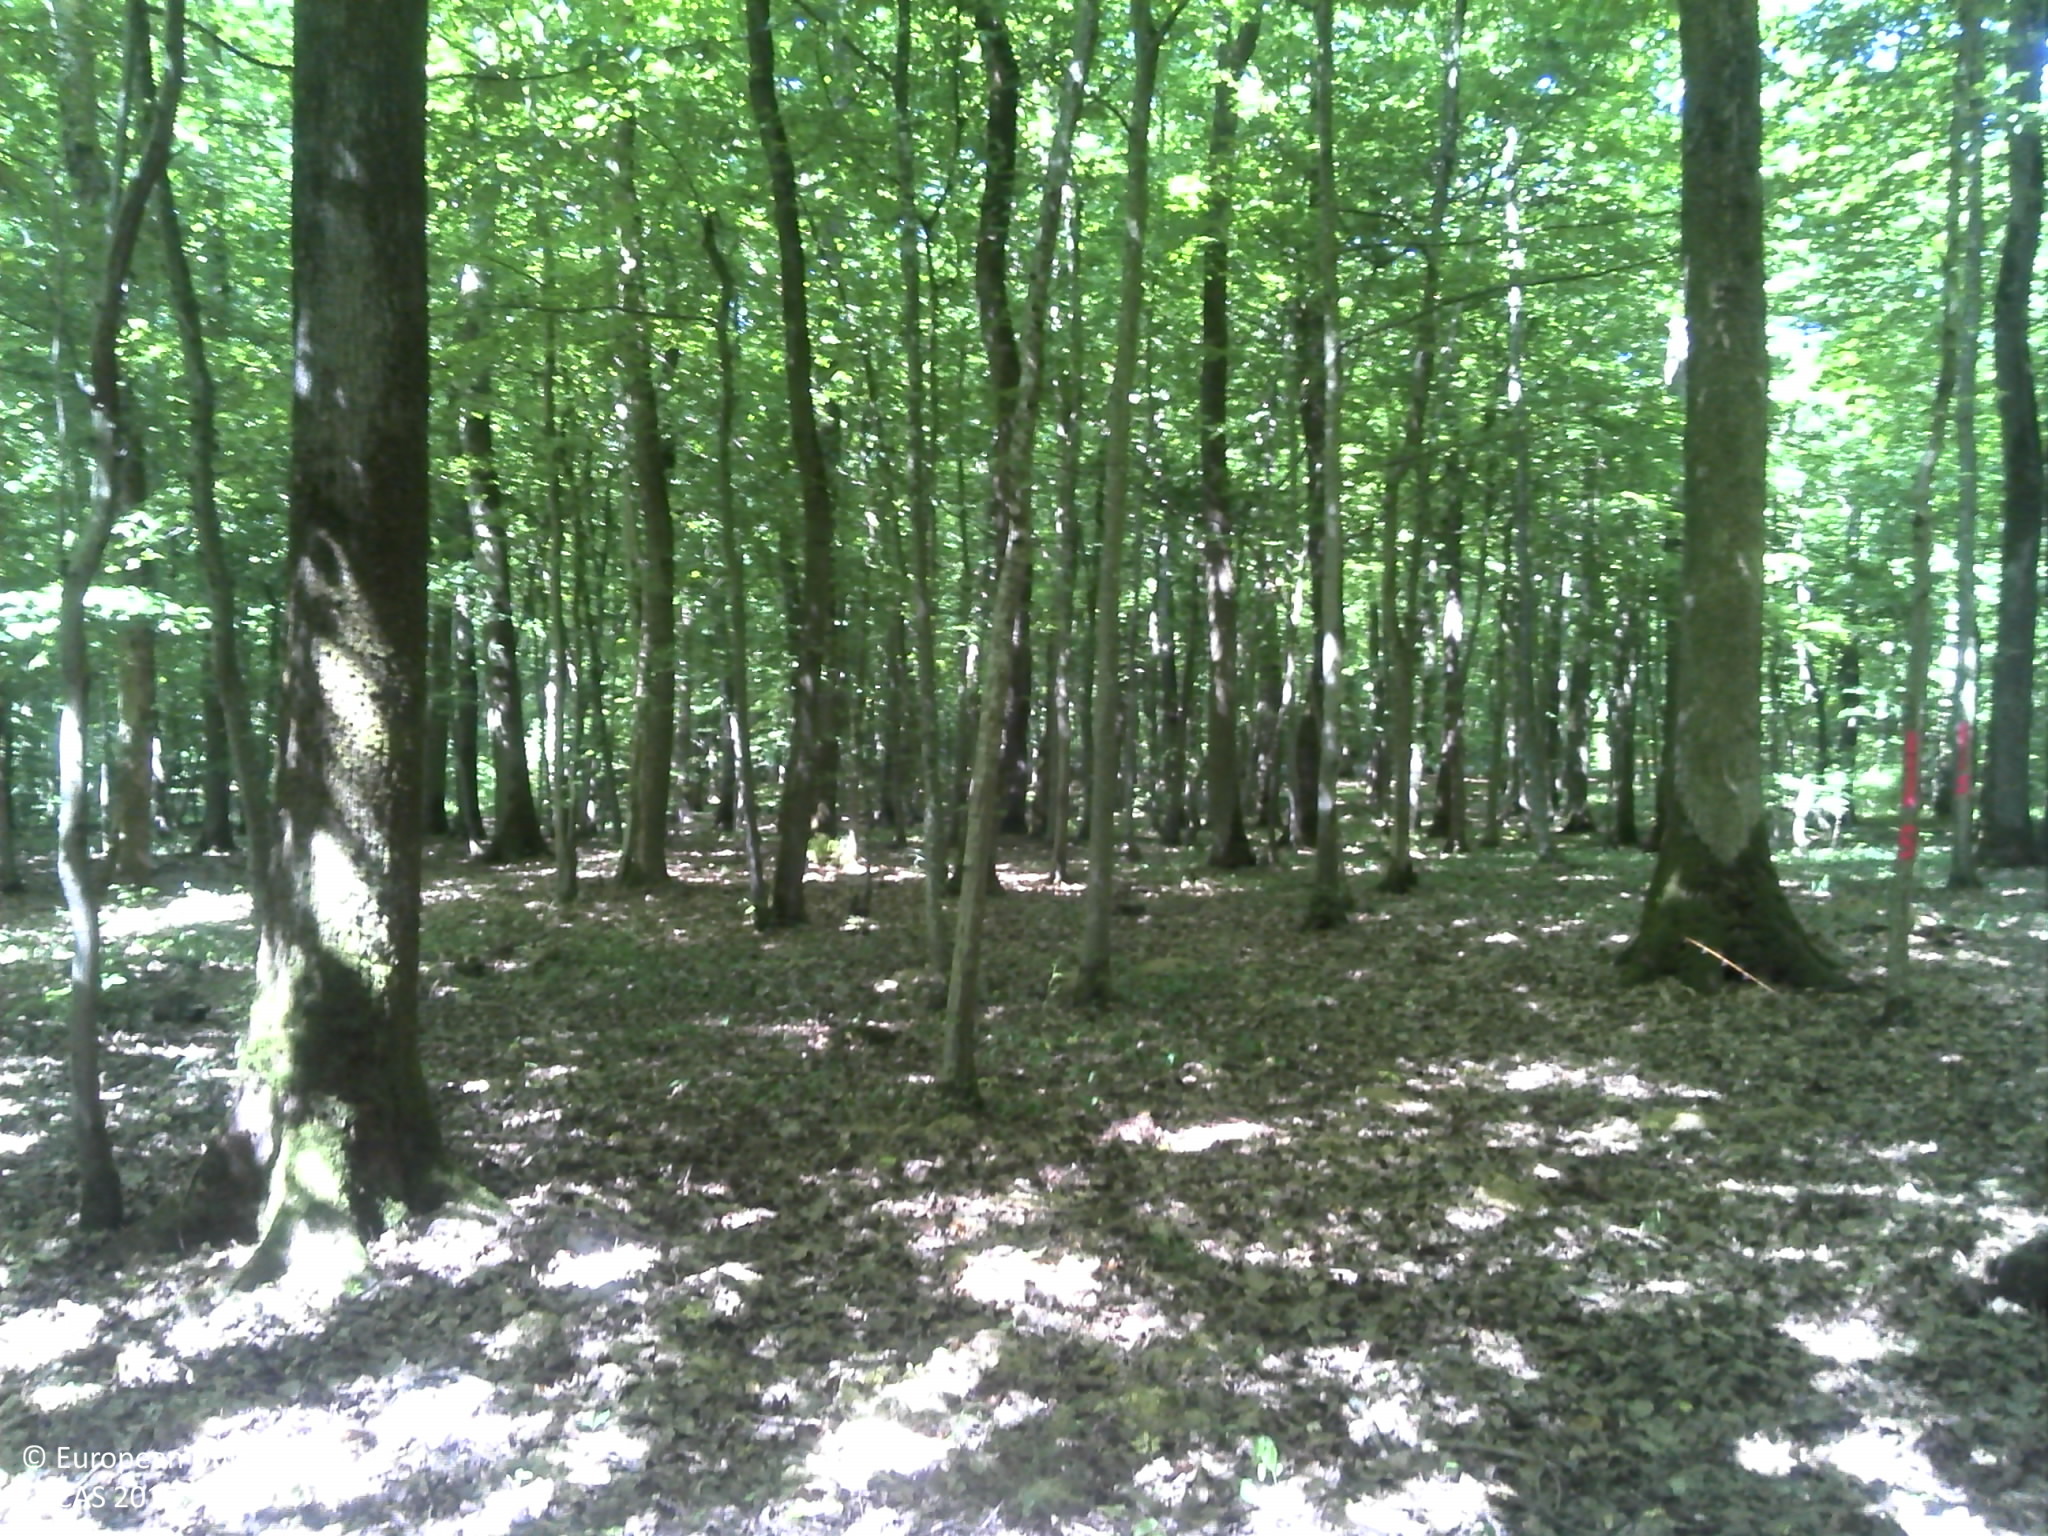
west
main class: Woodland
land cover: Broadleaved woodland
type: mesophytic deciduous forest
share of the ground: > 75 %
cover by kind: broadleaved forest trees 100 %
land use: Forestry
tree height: > 5 m
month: July
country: FR
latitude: 49.4711
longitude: 6.1494
